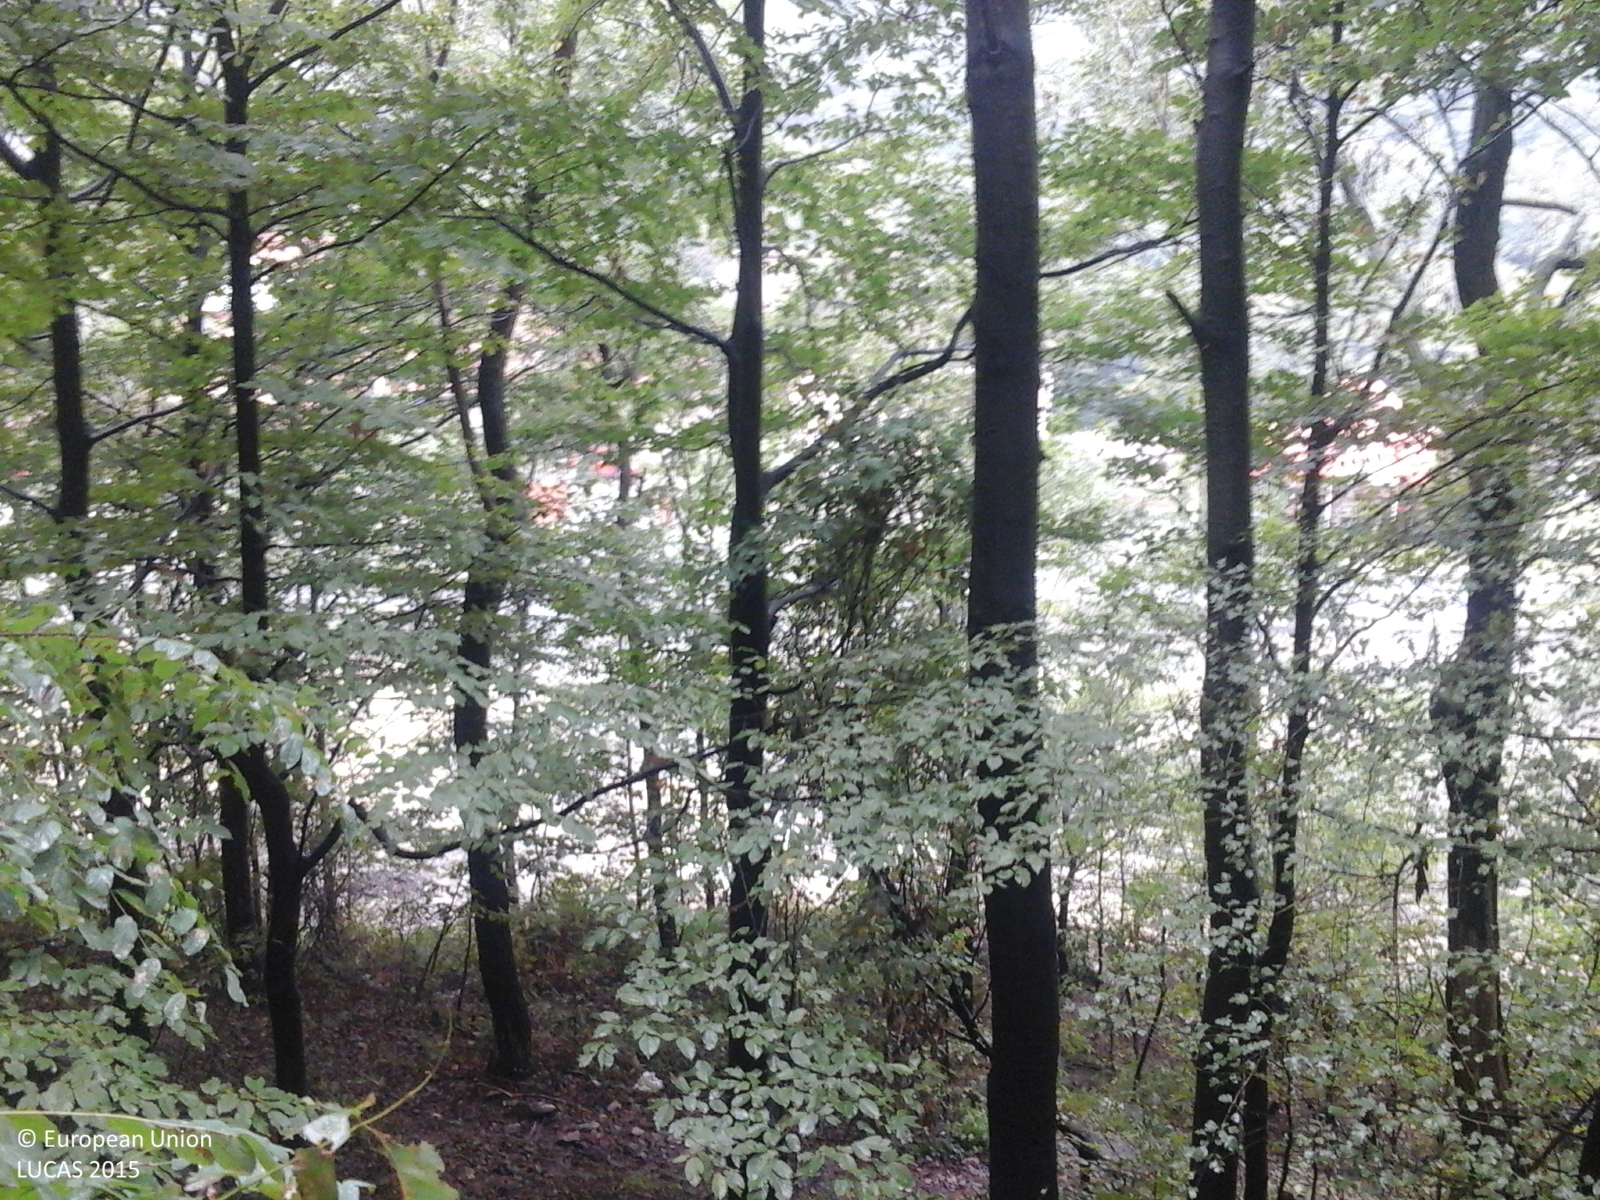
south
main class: Woodland
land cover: Broadleaved woodland
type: mesophytic deciduous forest
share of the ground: > 75 %
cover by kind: broadleaved forest trees 100 %
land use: Forestry
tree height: > 5 m
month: September
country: RO
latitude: 45.1953
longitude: 23.3843
